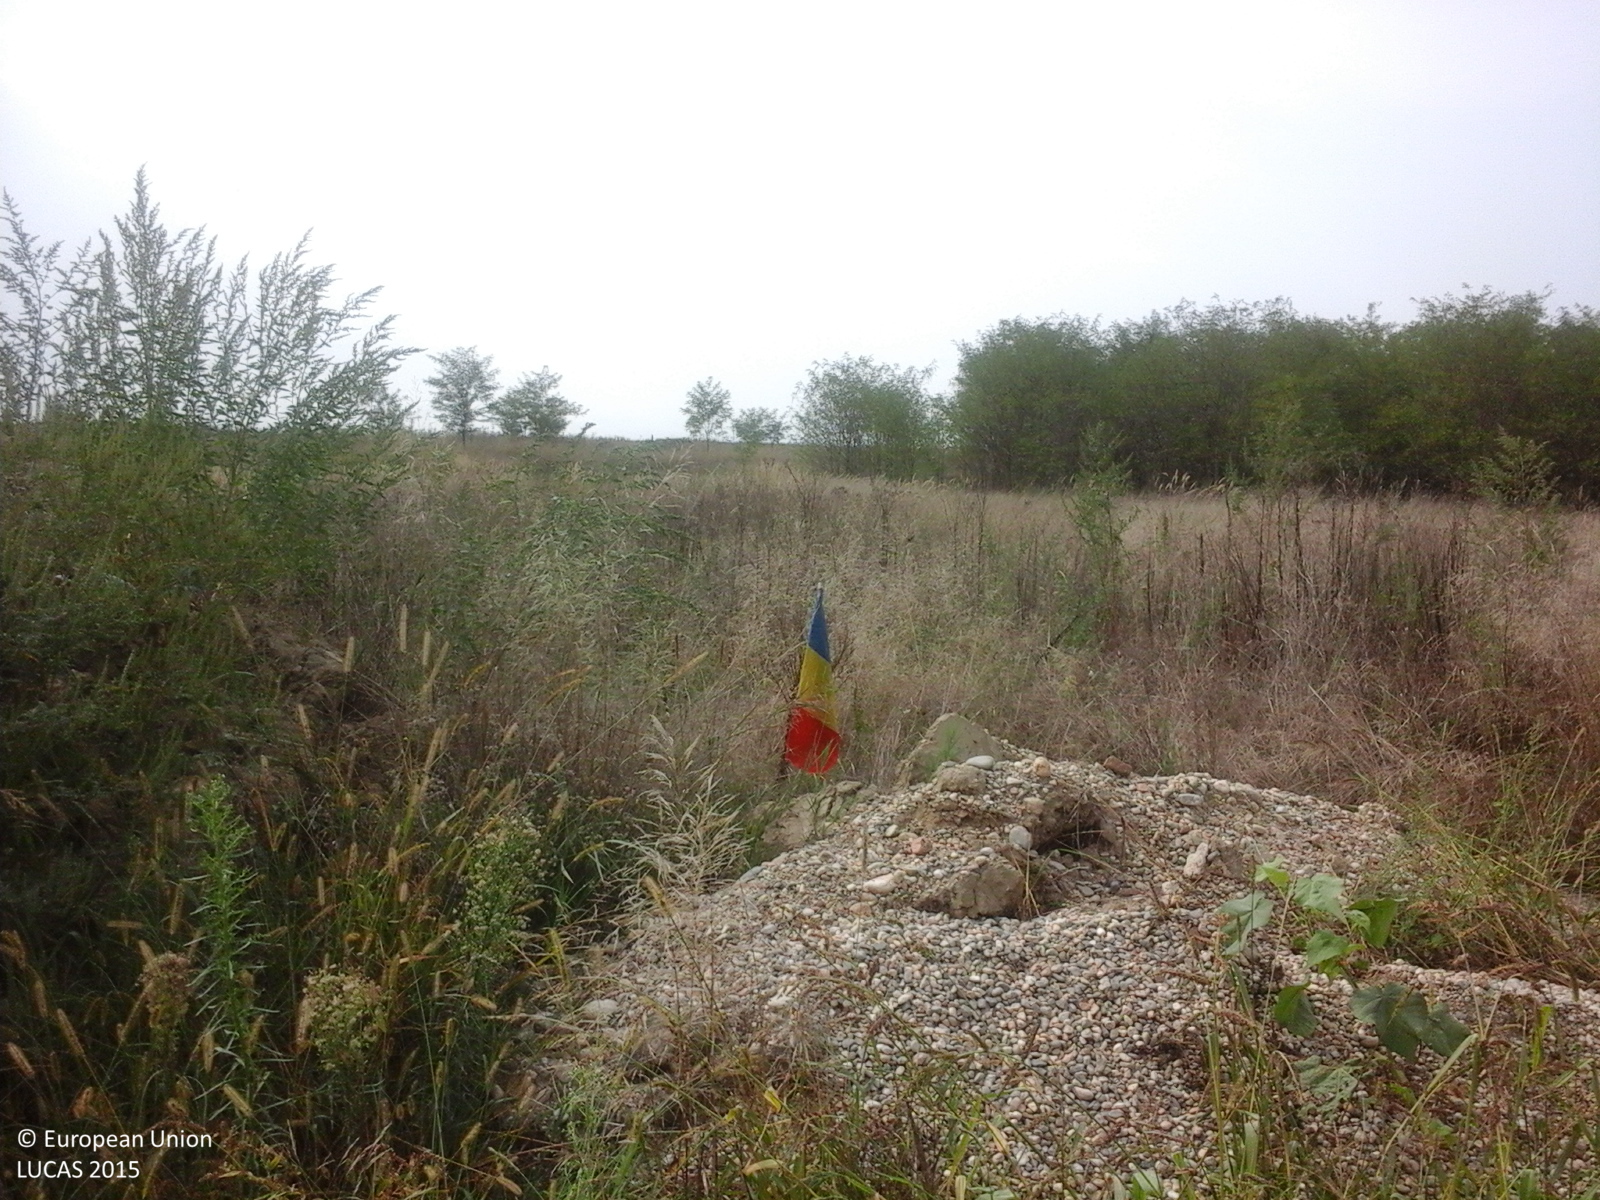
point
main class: Grassland
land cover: Spontaneously vegetated surfaces
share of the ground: 50 - 75 %
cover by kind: herbaceous plants 75 %, unconsolidated bare surface 25 %
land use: Mining and quarrying
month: September
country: RO
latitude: 45.6562
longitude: 21.9870
